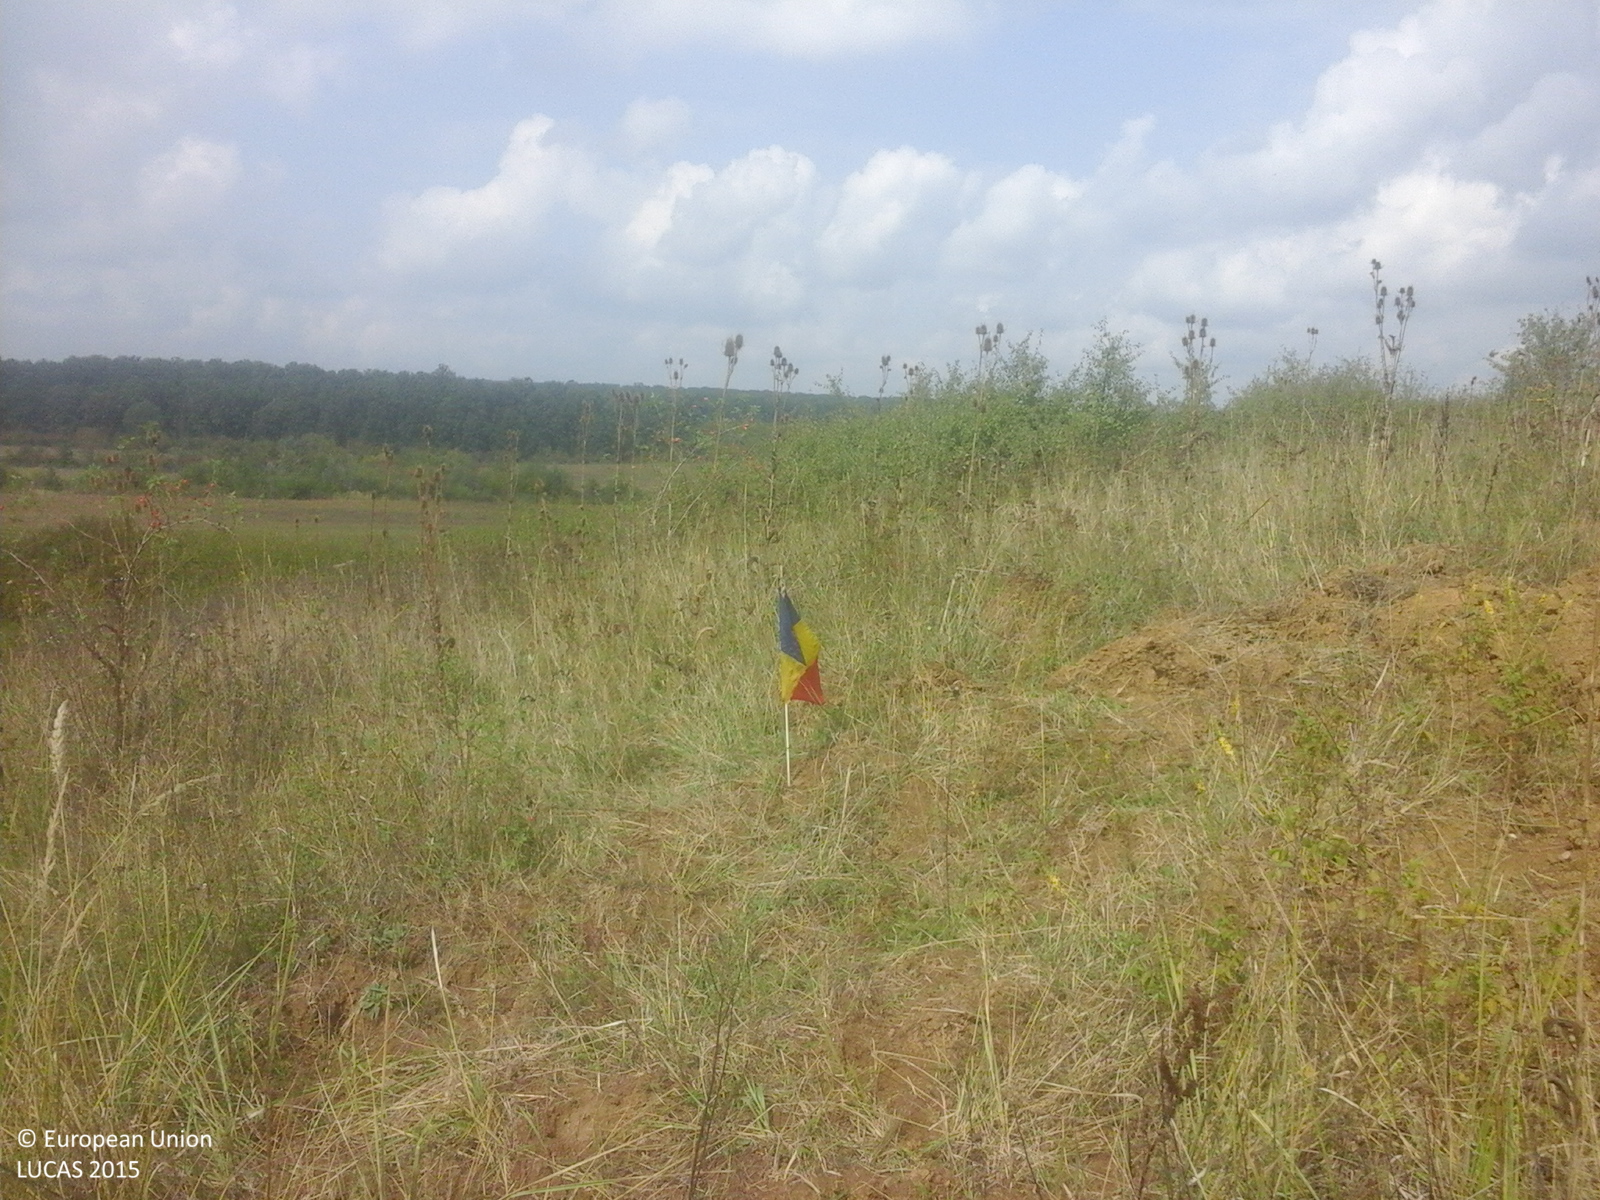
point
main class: Grassland
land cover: Spontaneously vegetated surfaces
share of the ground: > 75 %
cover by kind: herbaceous plants 100 %
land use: Fallow land
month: September
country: RO
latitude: 46.8444
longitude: 21.9390
